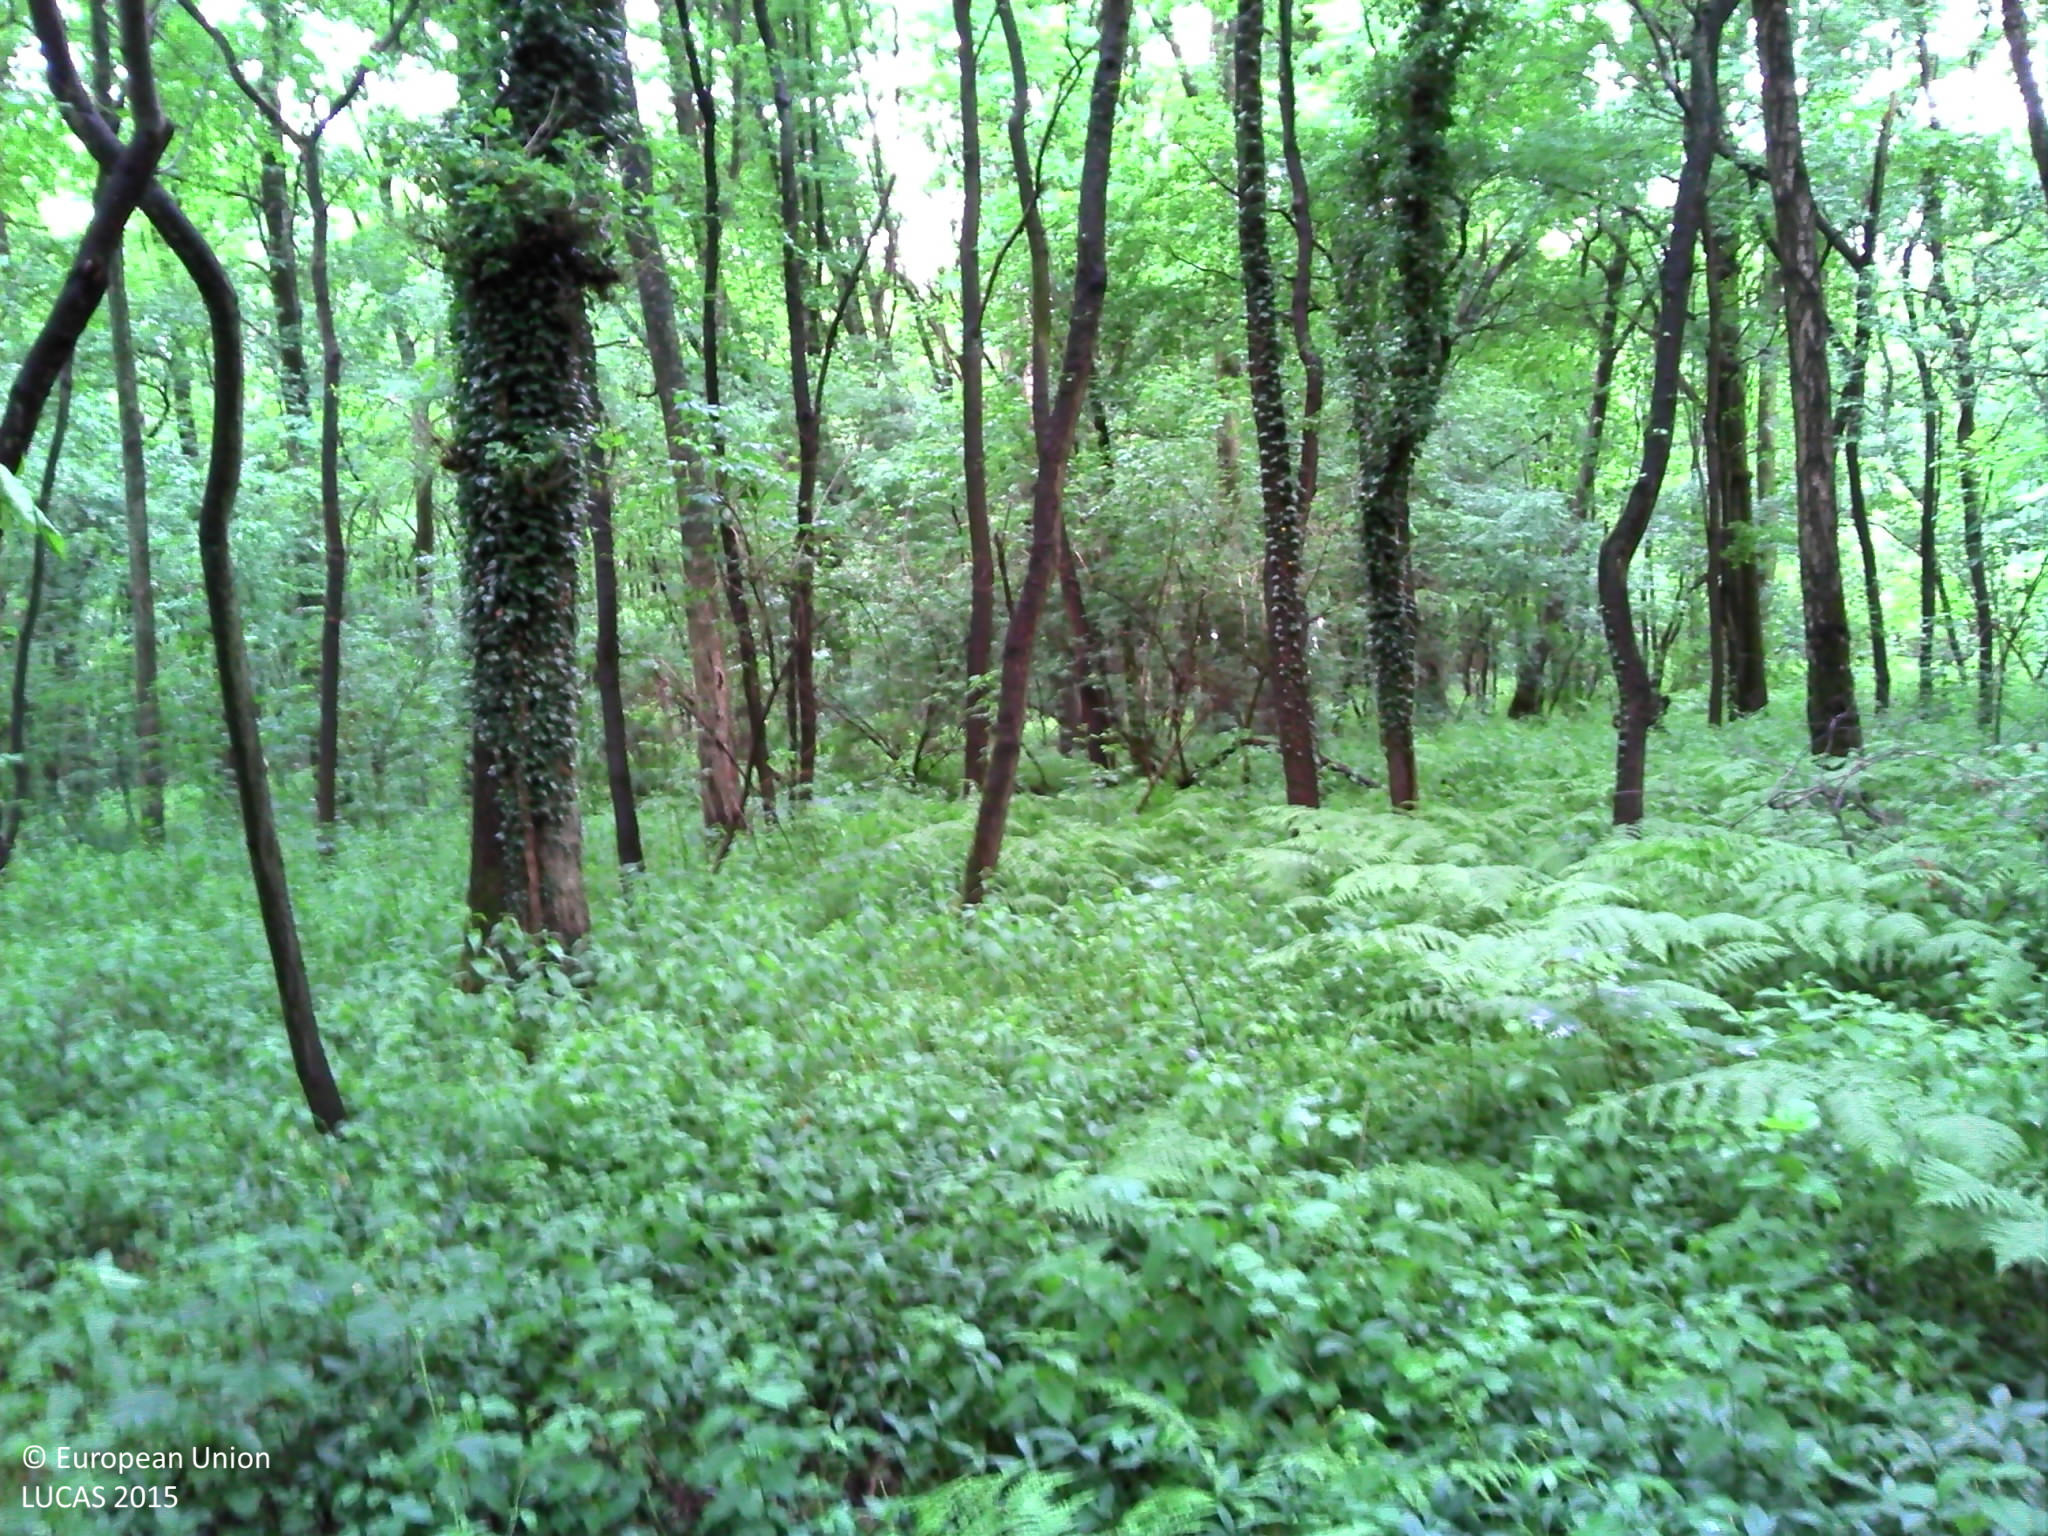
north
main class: Woodland
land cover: Broadleaved woodland
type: mesophytic deciduous forest
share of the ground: > 75 %
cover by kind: broadleaved forest trees 75 %, herbaceous plants 20 %, shrubs 5 %
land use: Forestry
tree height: > 5 m
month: June
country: BE
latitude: 50.4952
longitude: 4.0031
